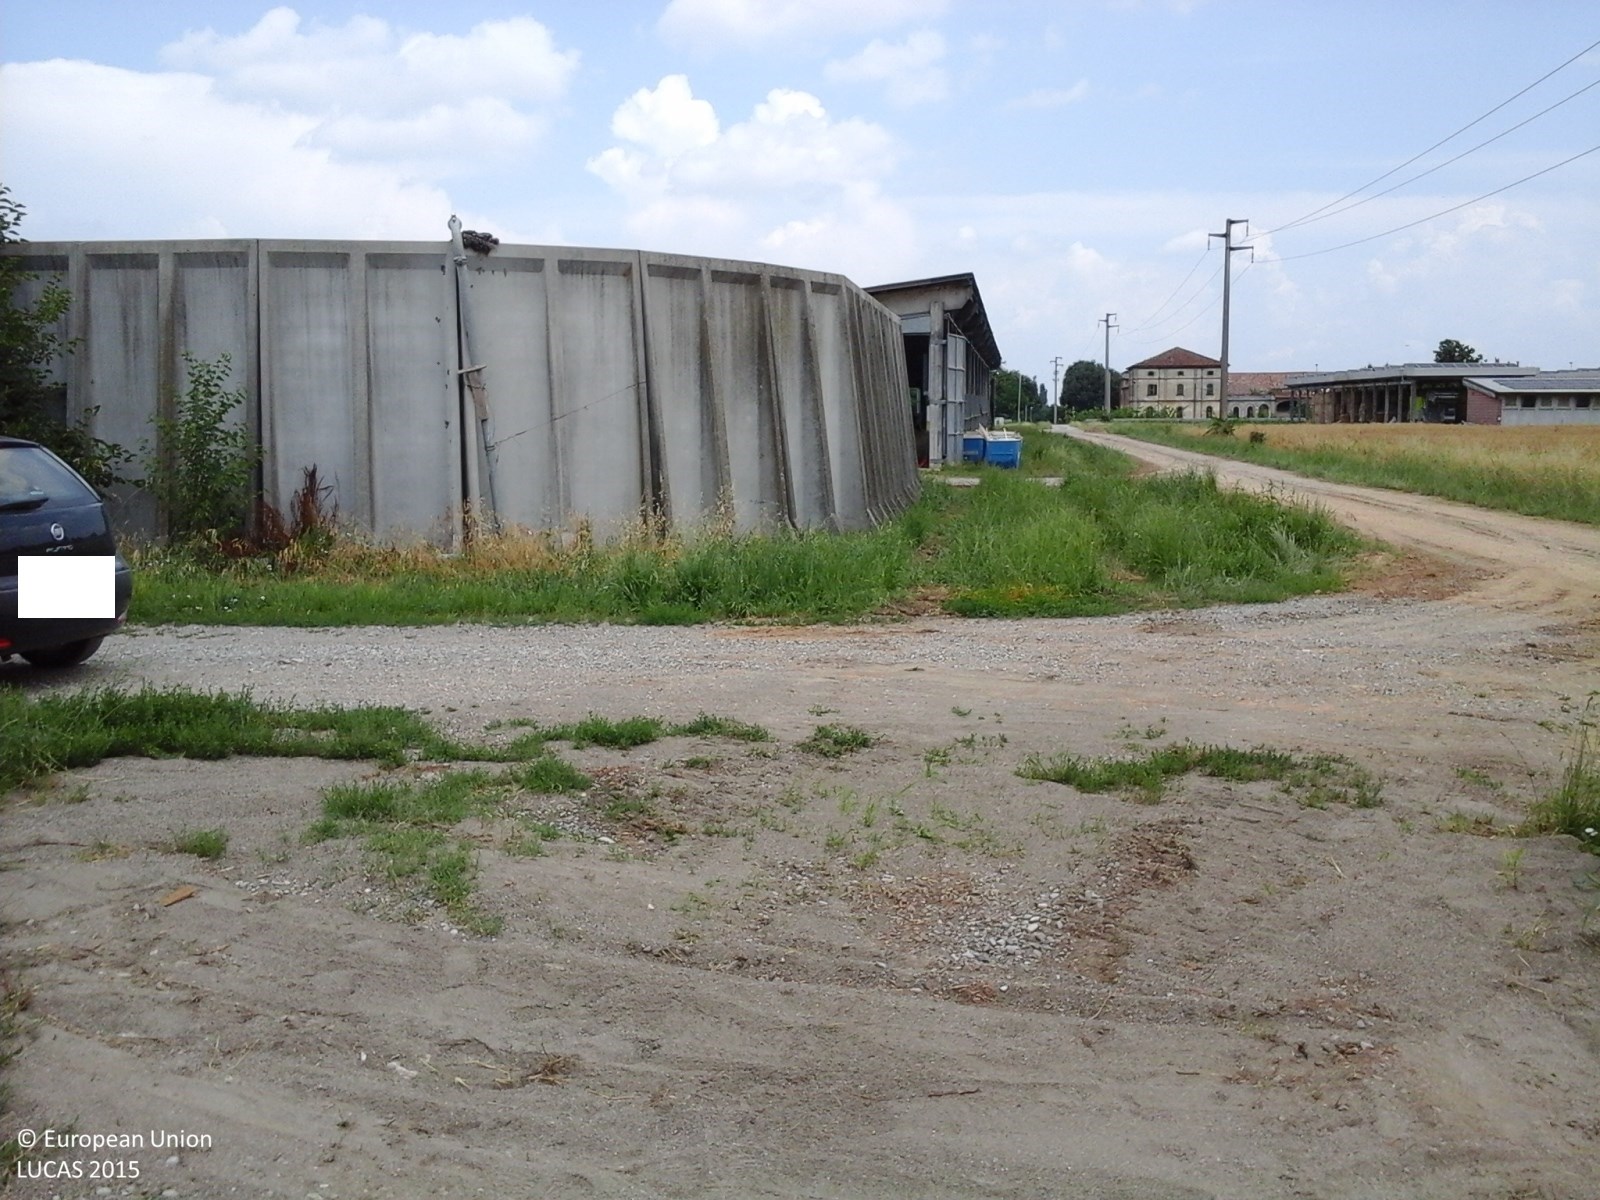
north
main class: Grassland
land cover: Grassland without tree/shrub cover
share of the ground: > 75 %
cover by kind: herbaceous plants 100 %
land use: Agriculture (excluding fallow land and kitchen gardens)
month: June
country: IT
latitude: 44.9812
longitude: 9.6836
